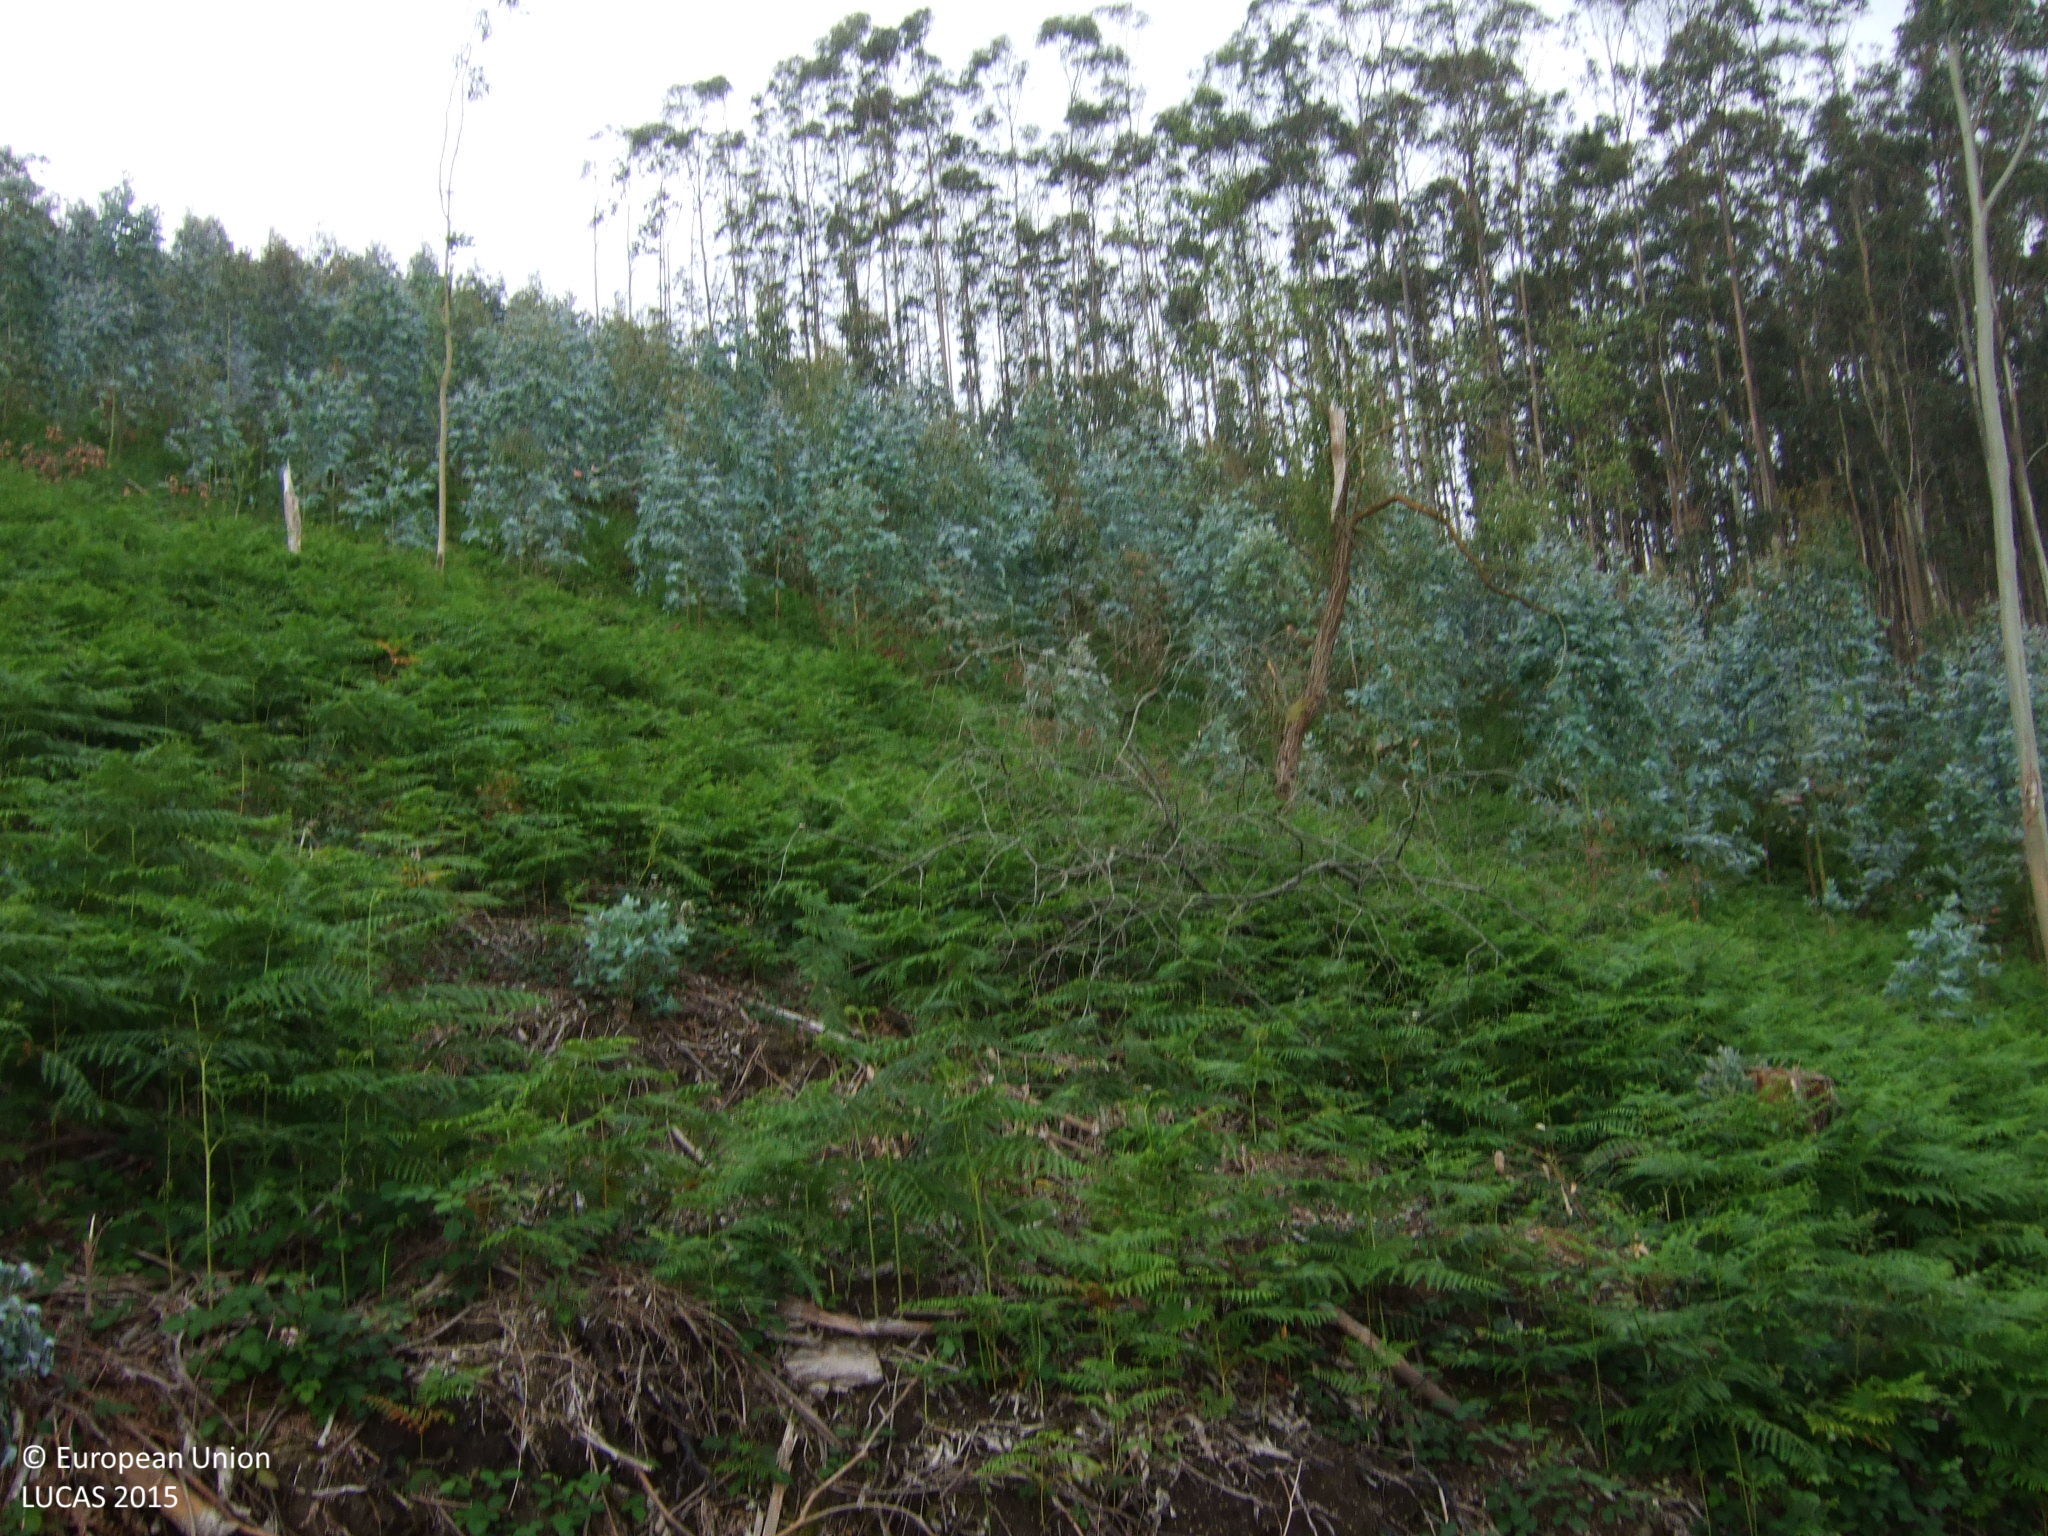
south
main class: Grassland
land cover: Spontaneously vegetated surfaces
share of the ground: 50 - 75 %
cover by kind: herbaceous plants 50 %, unconsolidated bare surface 50 %
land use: Forestry
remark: Clear cut
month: June
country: ES
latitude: 43.4973
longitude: -7.4813
